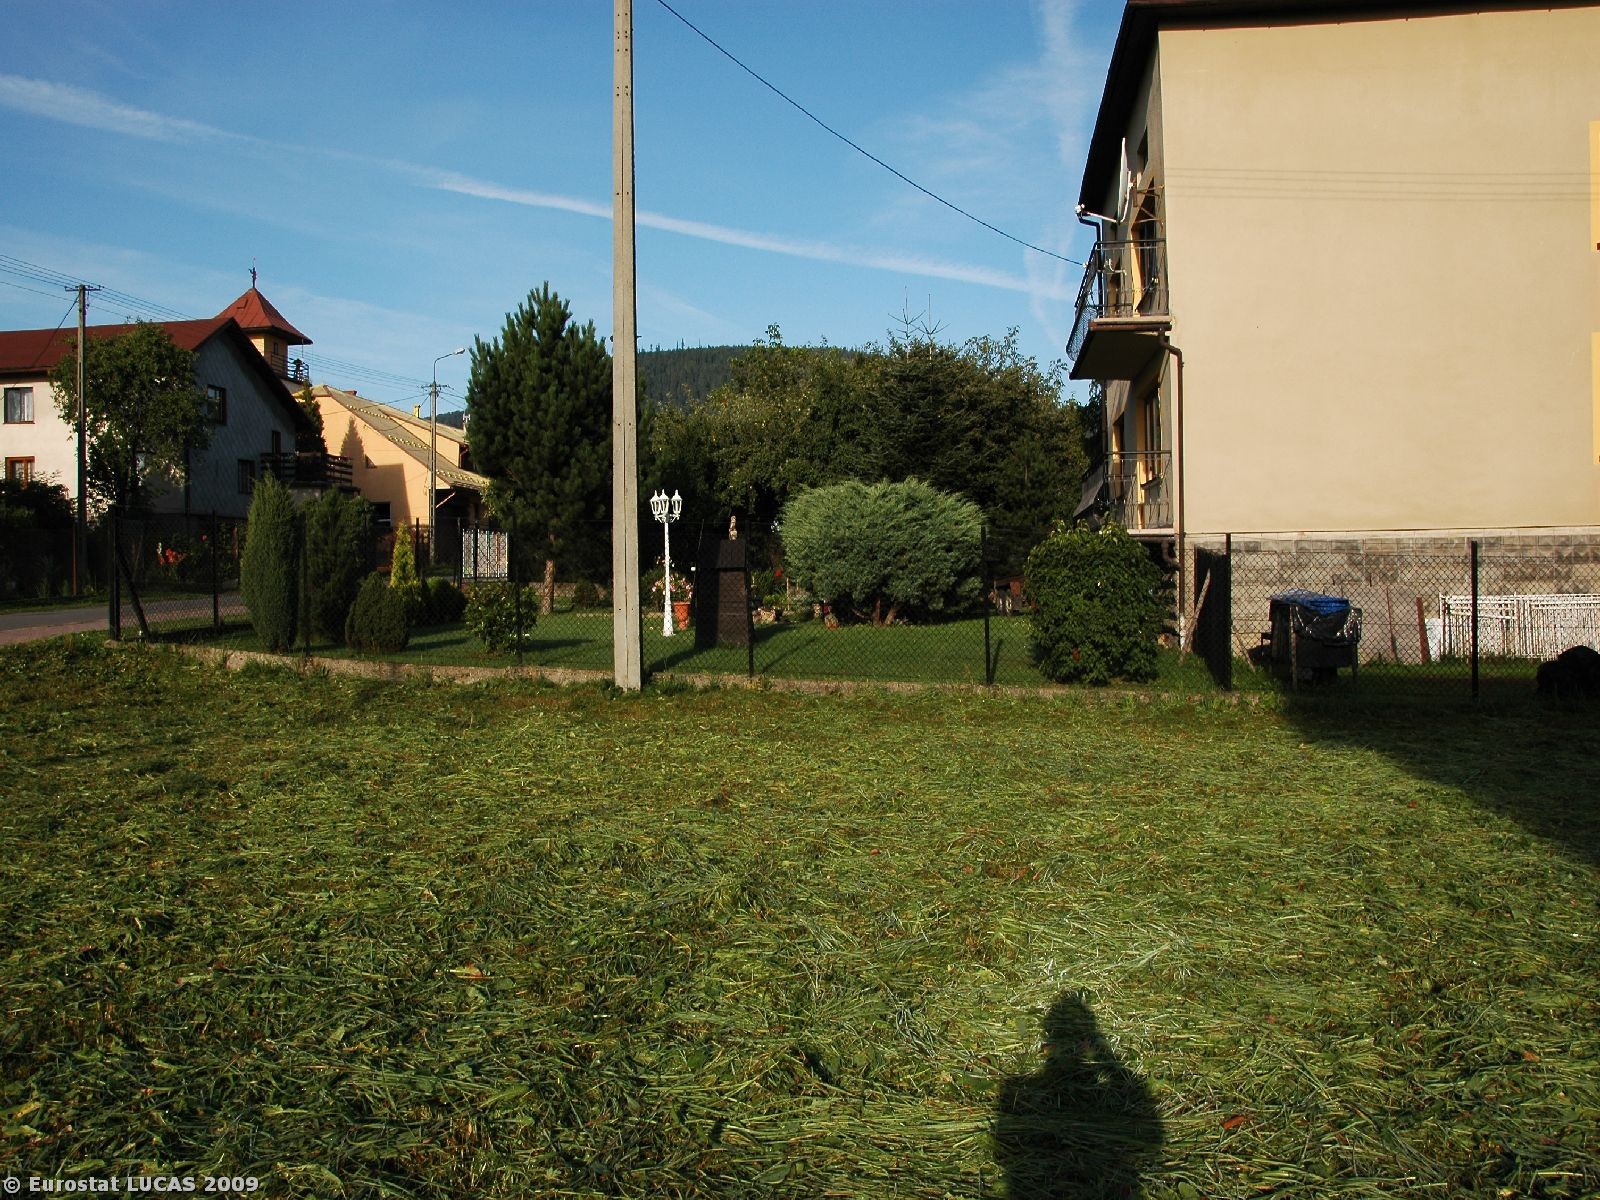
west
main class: Grassland
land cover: Grassland without tree/shrub cover
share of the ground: 25 - 50 %
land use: Agriculture (excluding fallow land and kitchen gardens)
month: September
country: PL
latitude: 49.7128
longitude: 19.0793
